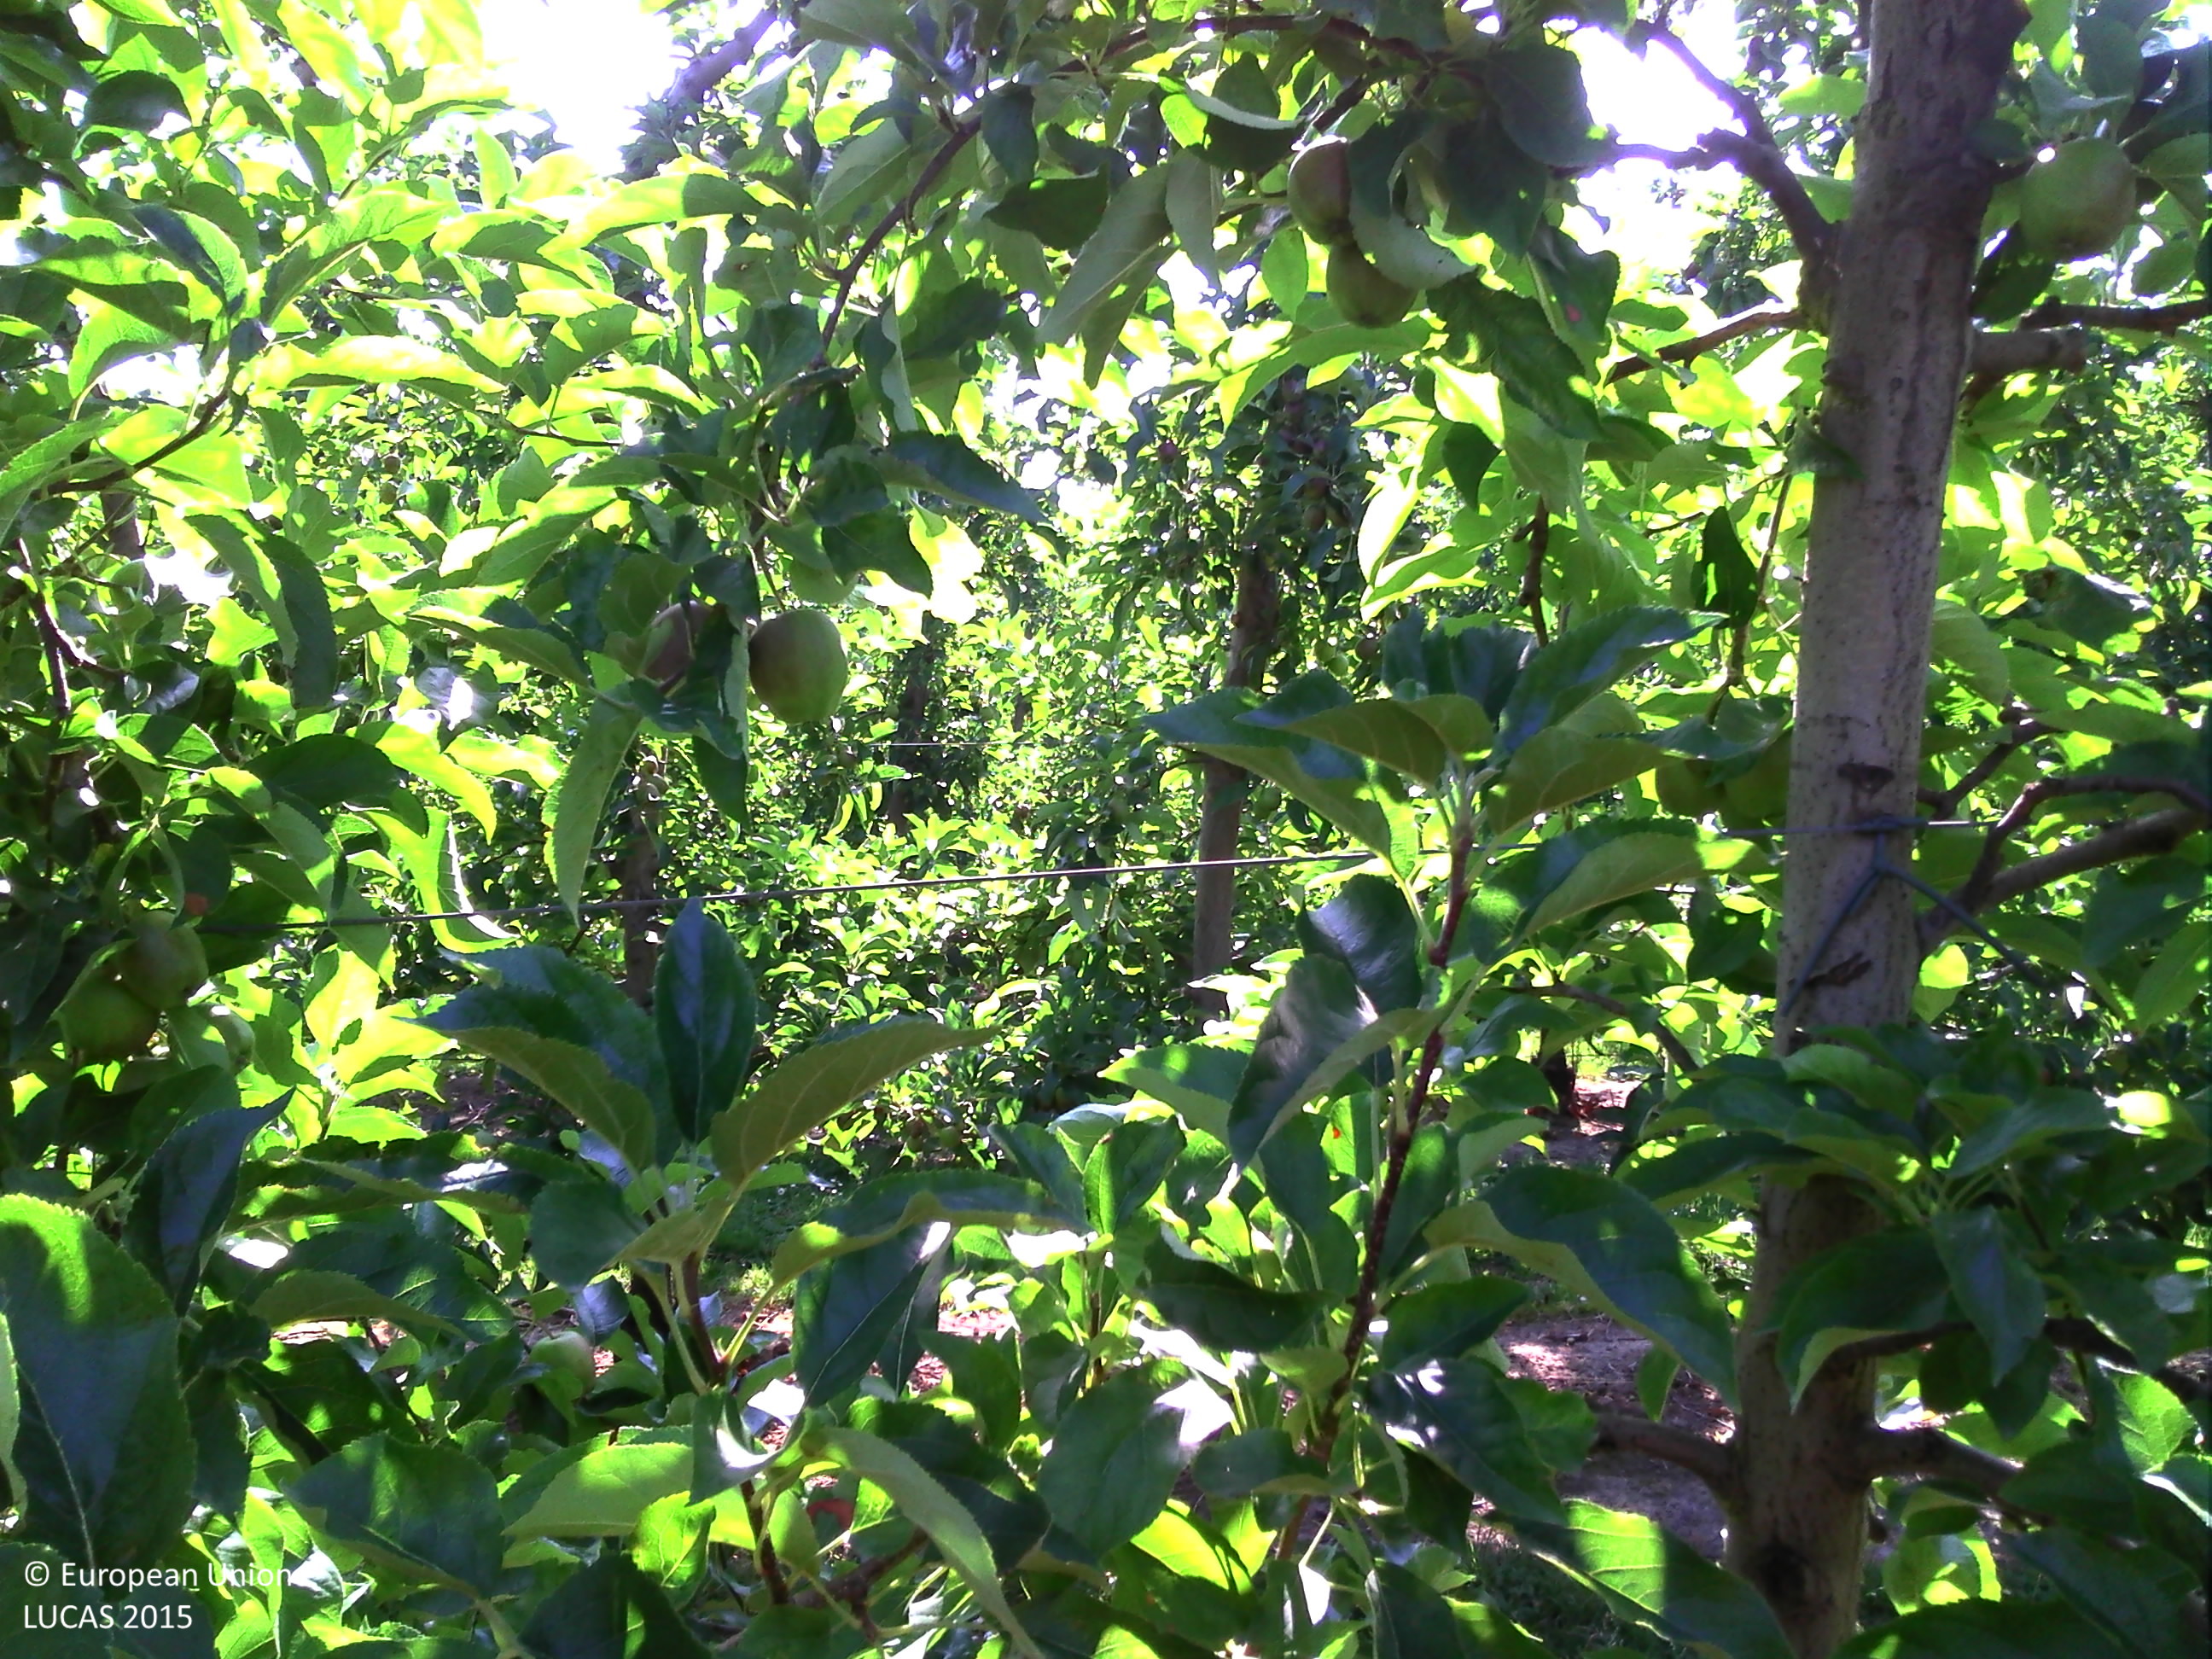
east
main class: Cropland
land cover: Apple fruit
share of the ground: > 75 %
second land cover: Grassland without tree/shrub cover
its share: > 75 %
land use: Agriculture (excluding fallow land and kitchen gardens)
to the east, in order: Apple fruit; Grassland without tree/shrub cover; Abandoned hedges; Fences; Spontaneously vegetated surfaces; Paved roads, cycling and walking lanes; Grass margins; Lines of trees; Fences; Spontaneously vegetated surfaces; Fences; Other bare soil; Artificial constructions in urban areas; Spontaneously vegetated surfaces; Fences; Spontaneously vegetated surfaces
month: June
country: BE
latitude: 50.8032
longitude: 5.1873
